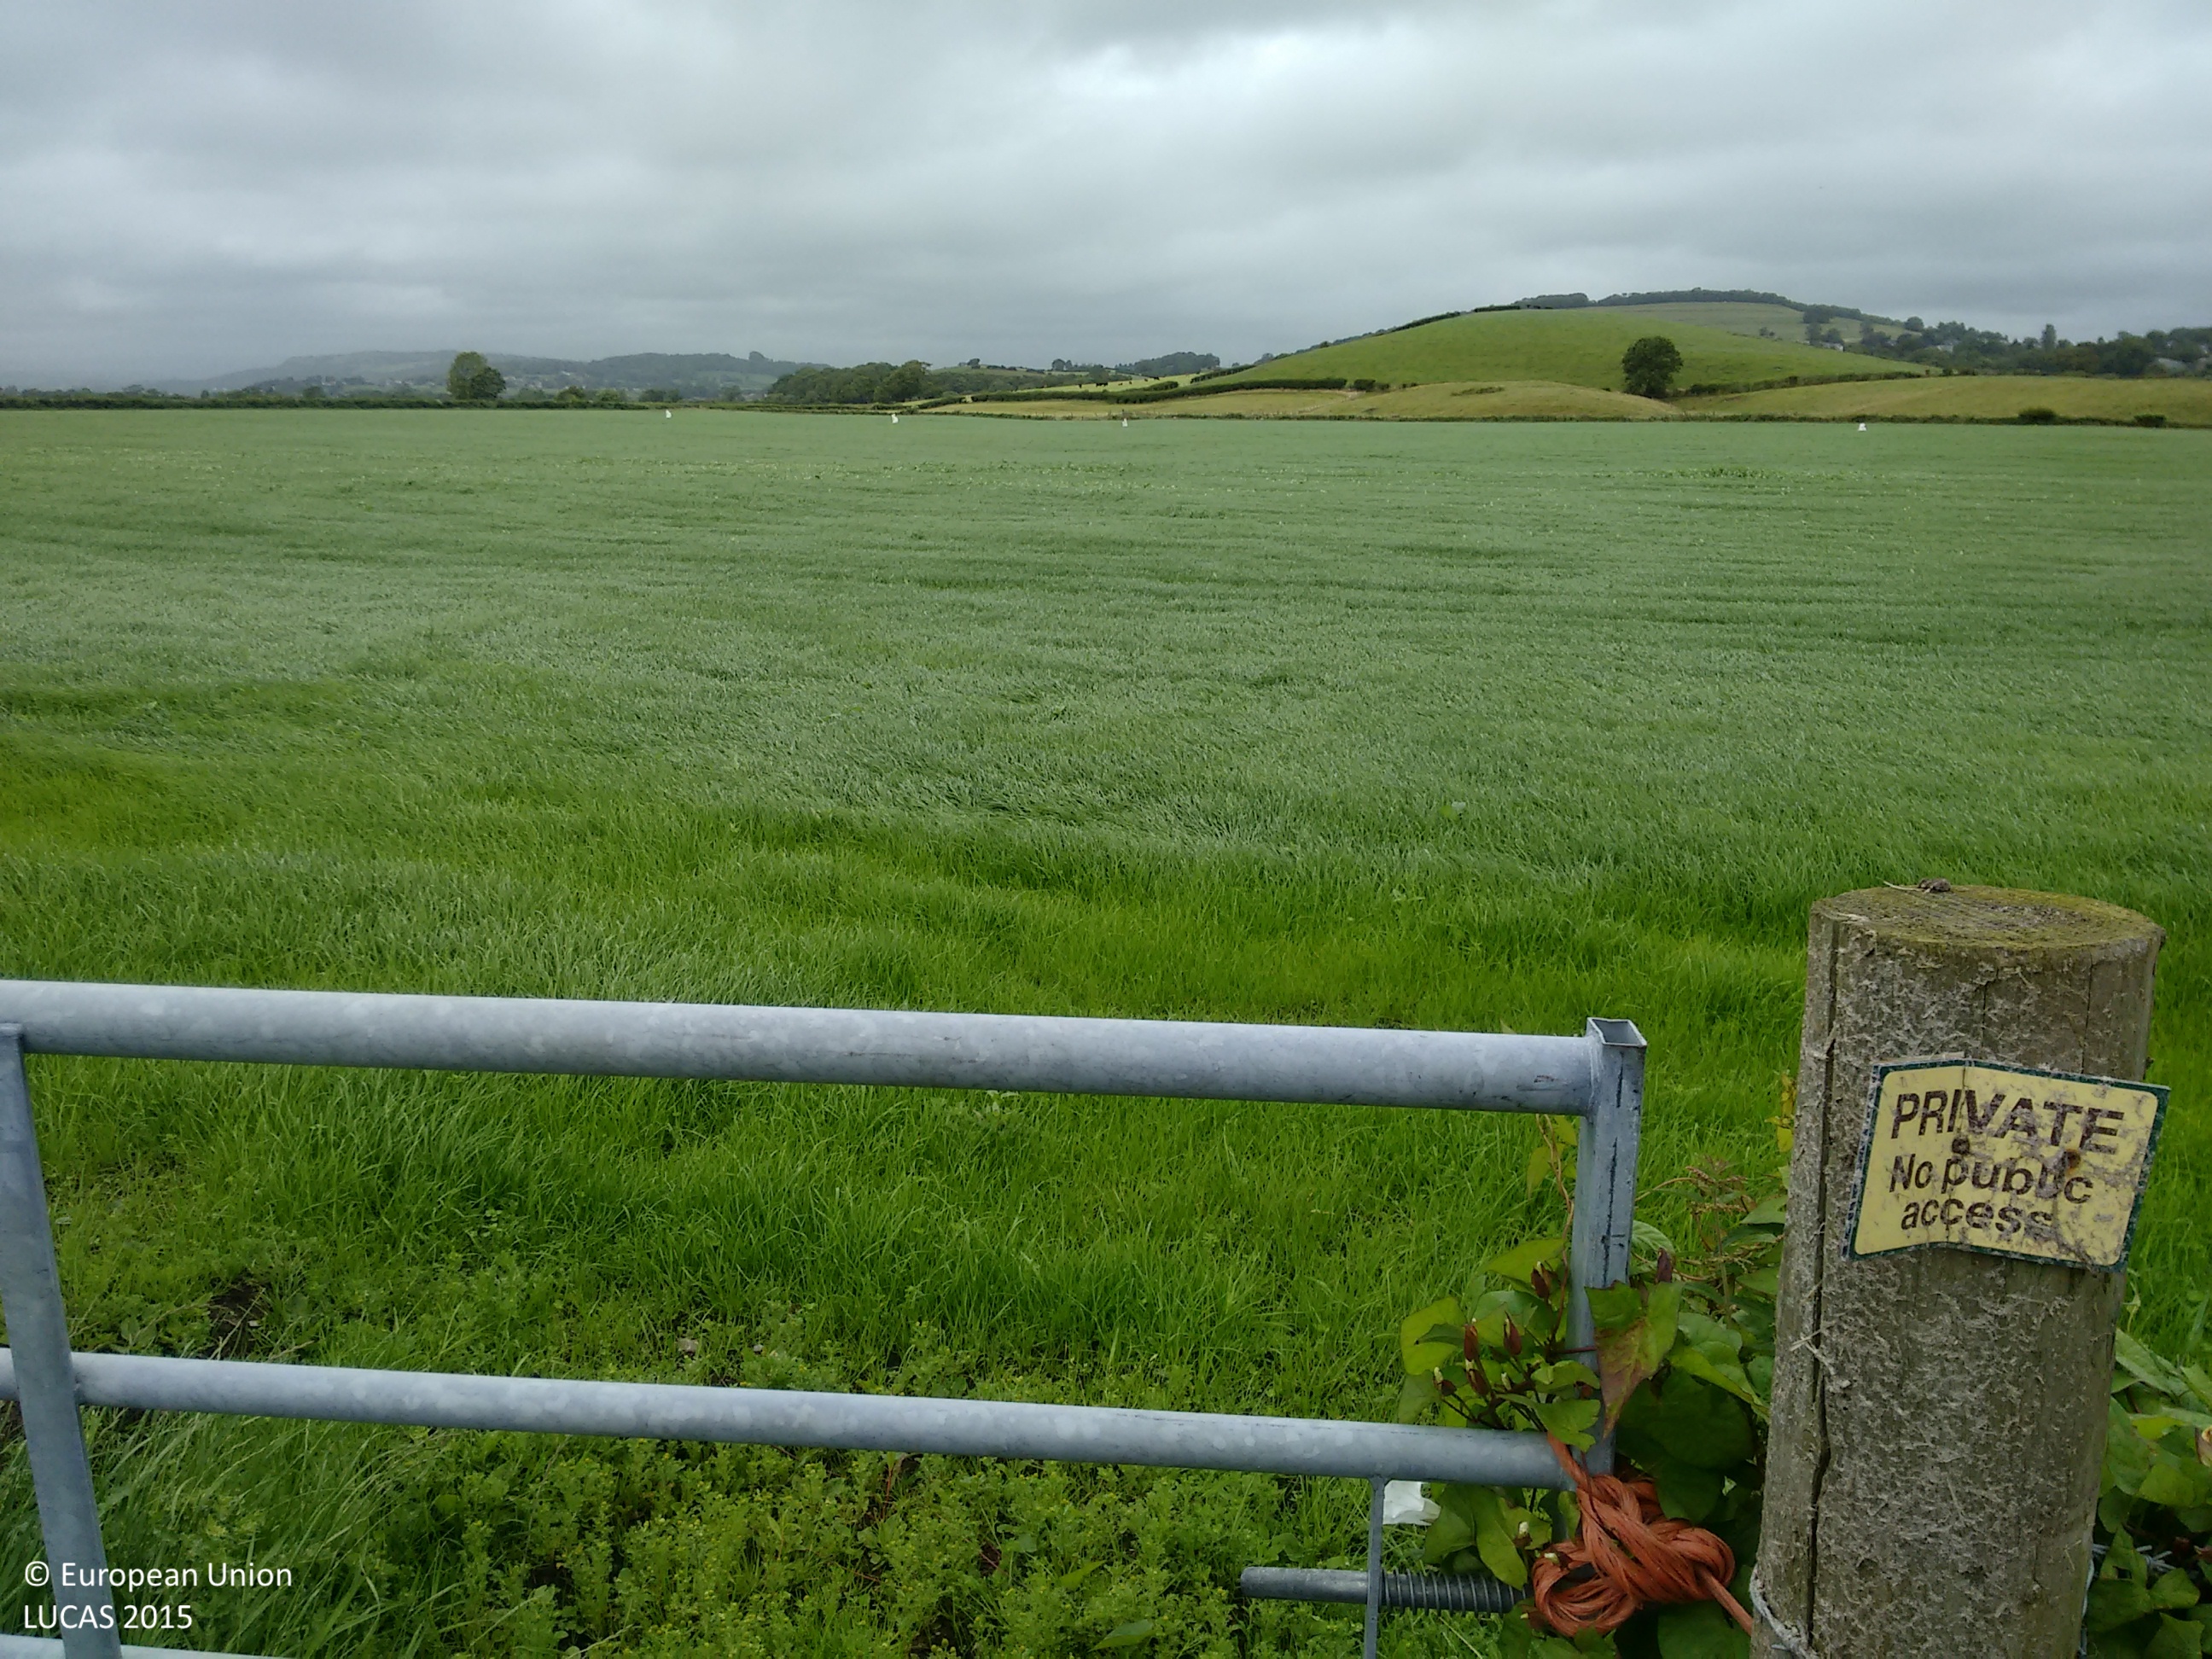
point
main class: Grassland
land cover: Grassland without tree/shrub cover
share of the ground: > 75 %
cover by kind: herbaceous plants 100 %
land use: Agriculture (excluding fallow land and kitchen gardens)
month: August
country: GB
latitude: 54.2325
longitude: -2.7872
